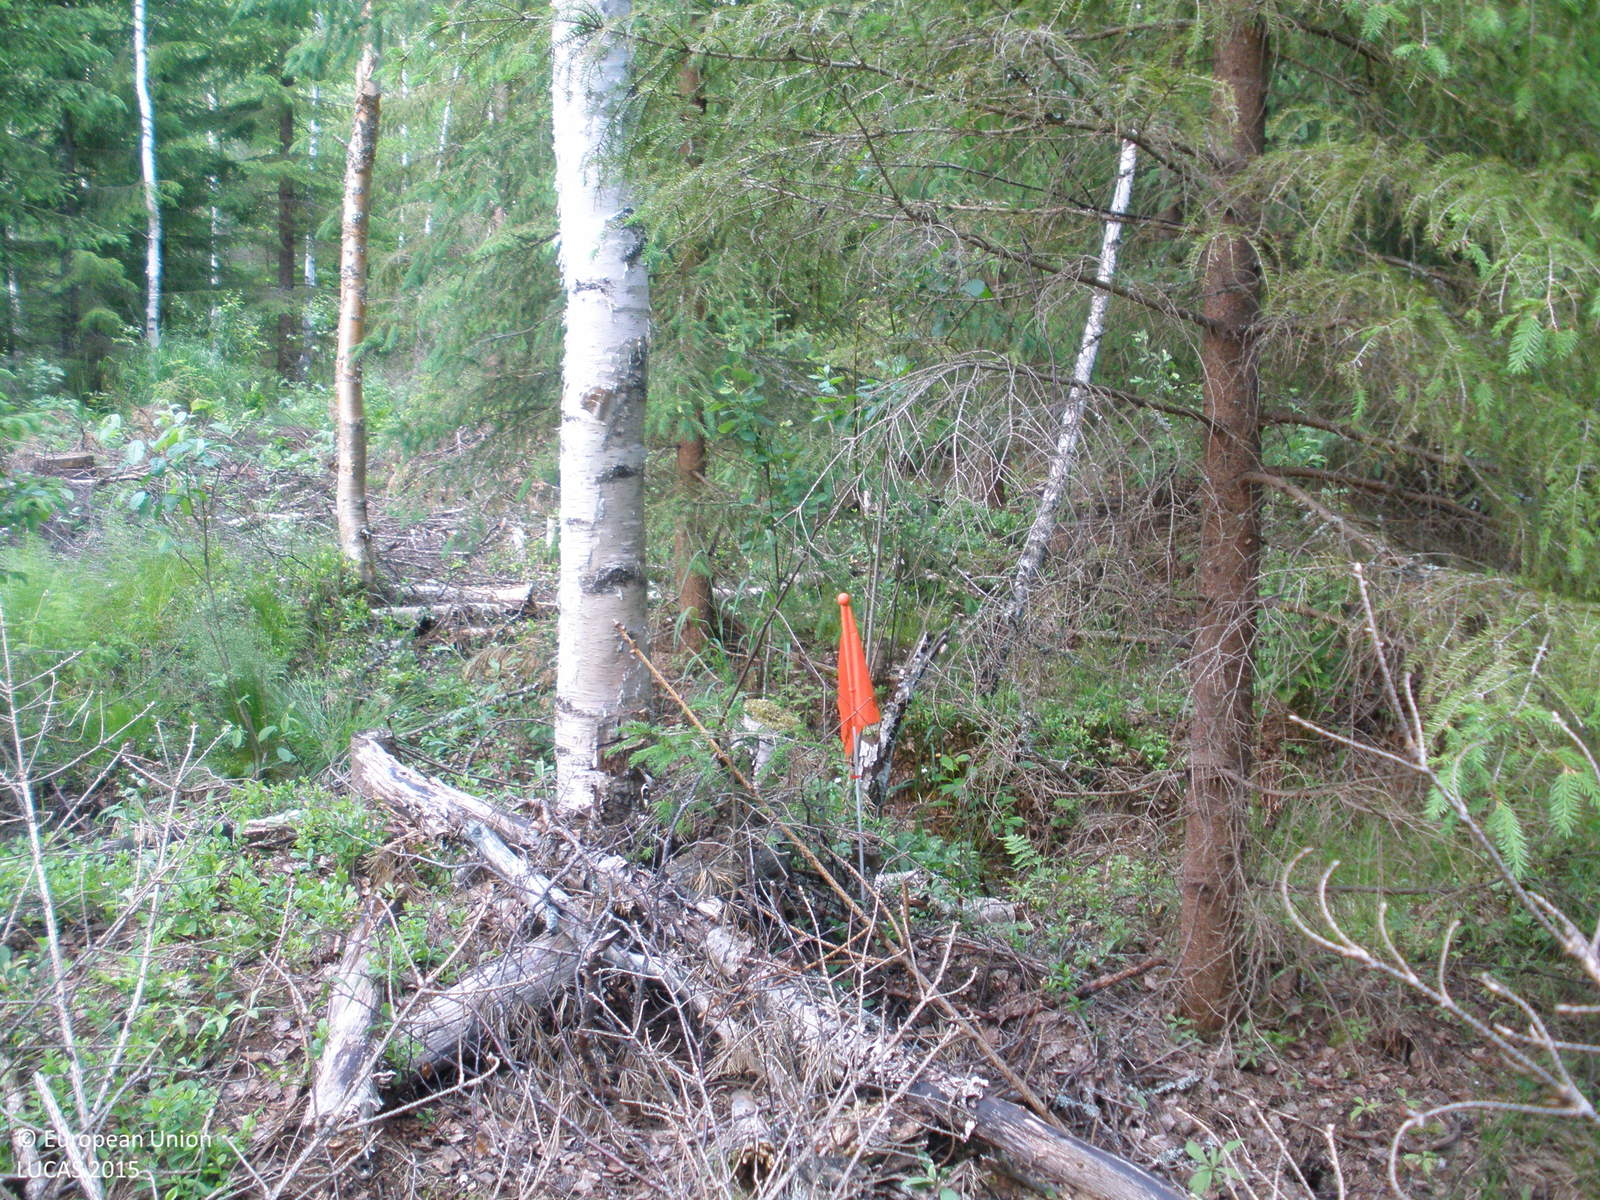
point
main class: Woodland
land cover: Spruce dominated mixed woodland
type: boreal forest
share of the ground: > 75 %
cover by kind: coniferous forest trees 55 %, broadleaved forest trees 25 %, shrubs 5 %, herbaceous plants 5 %, lichens and mosses 5 %
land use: Forestry
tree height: > 5 m
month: June
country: FI
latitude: 61.0979
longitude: 24.6654
